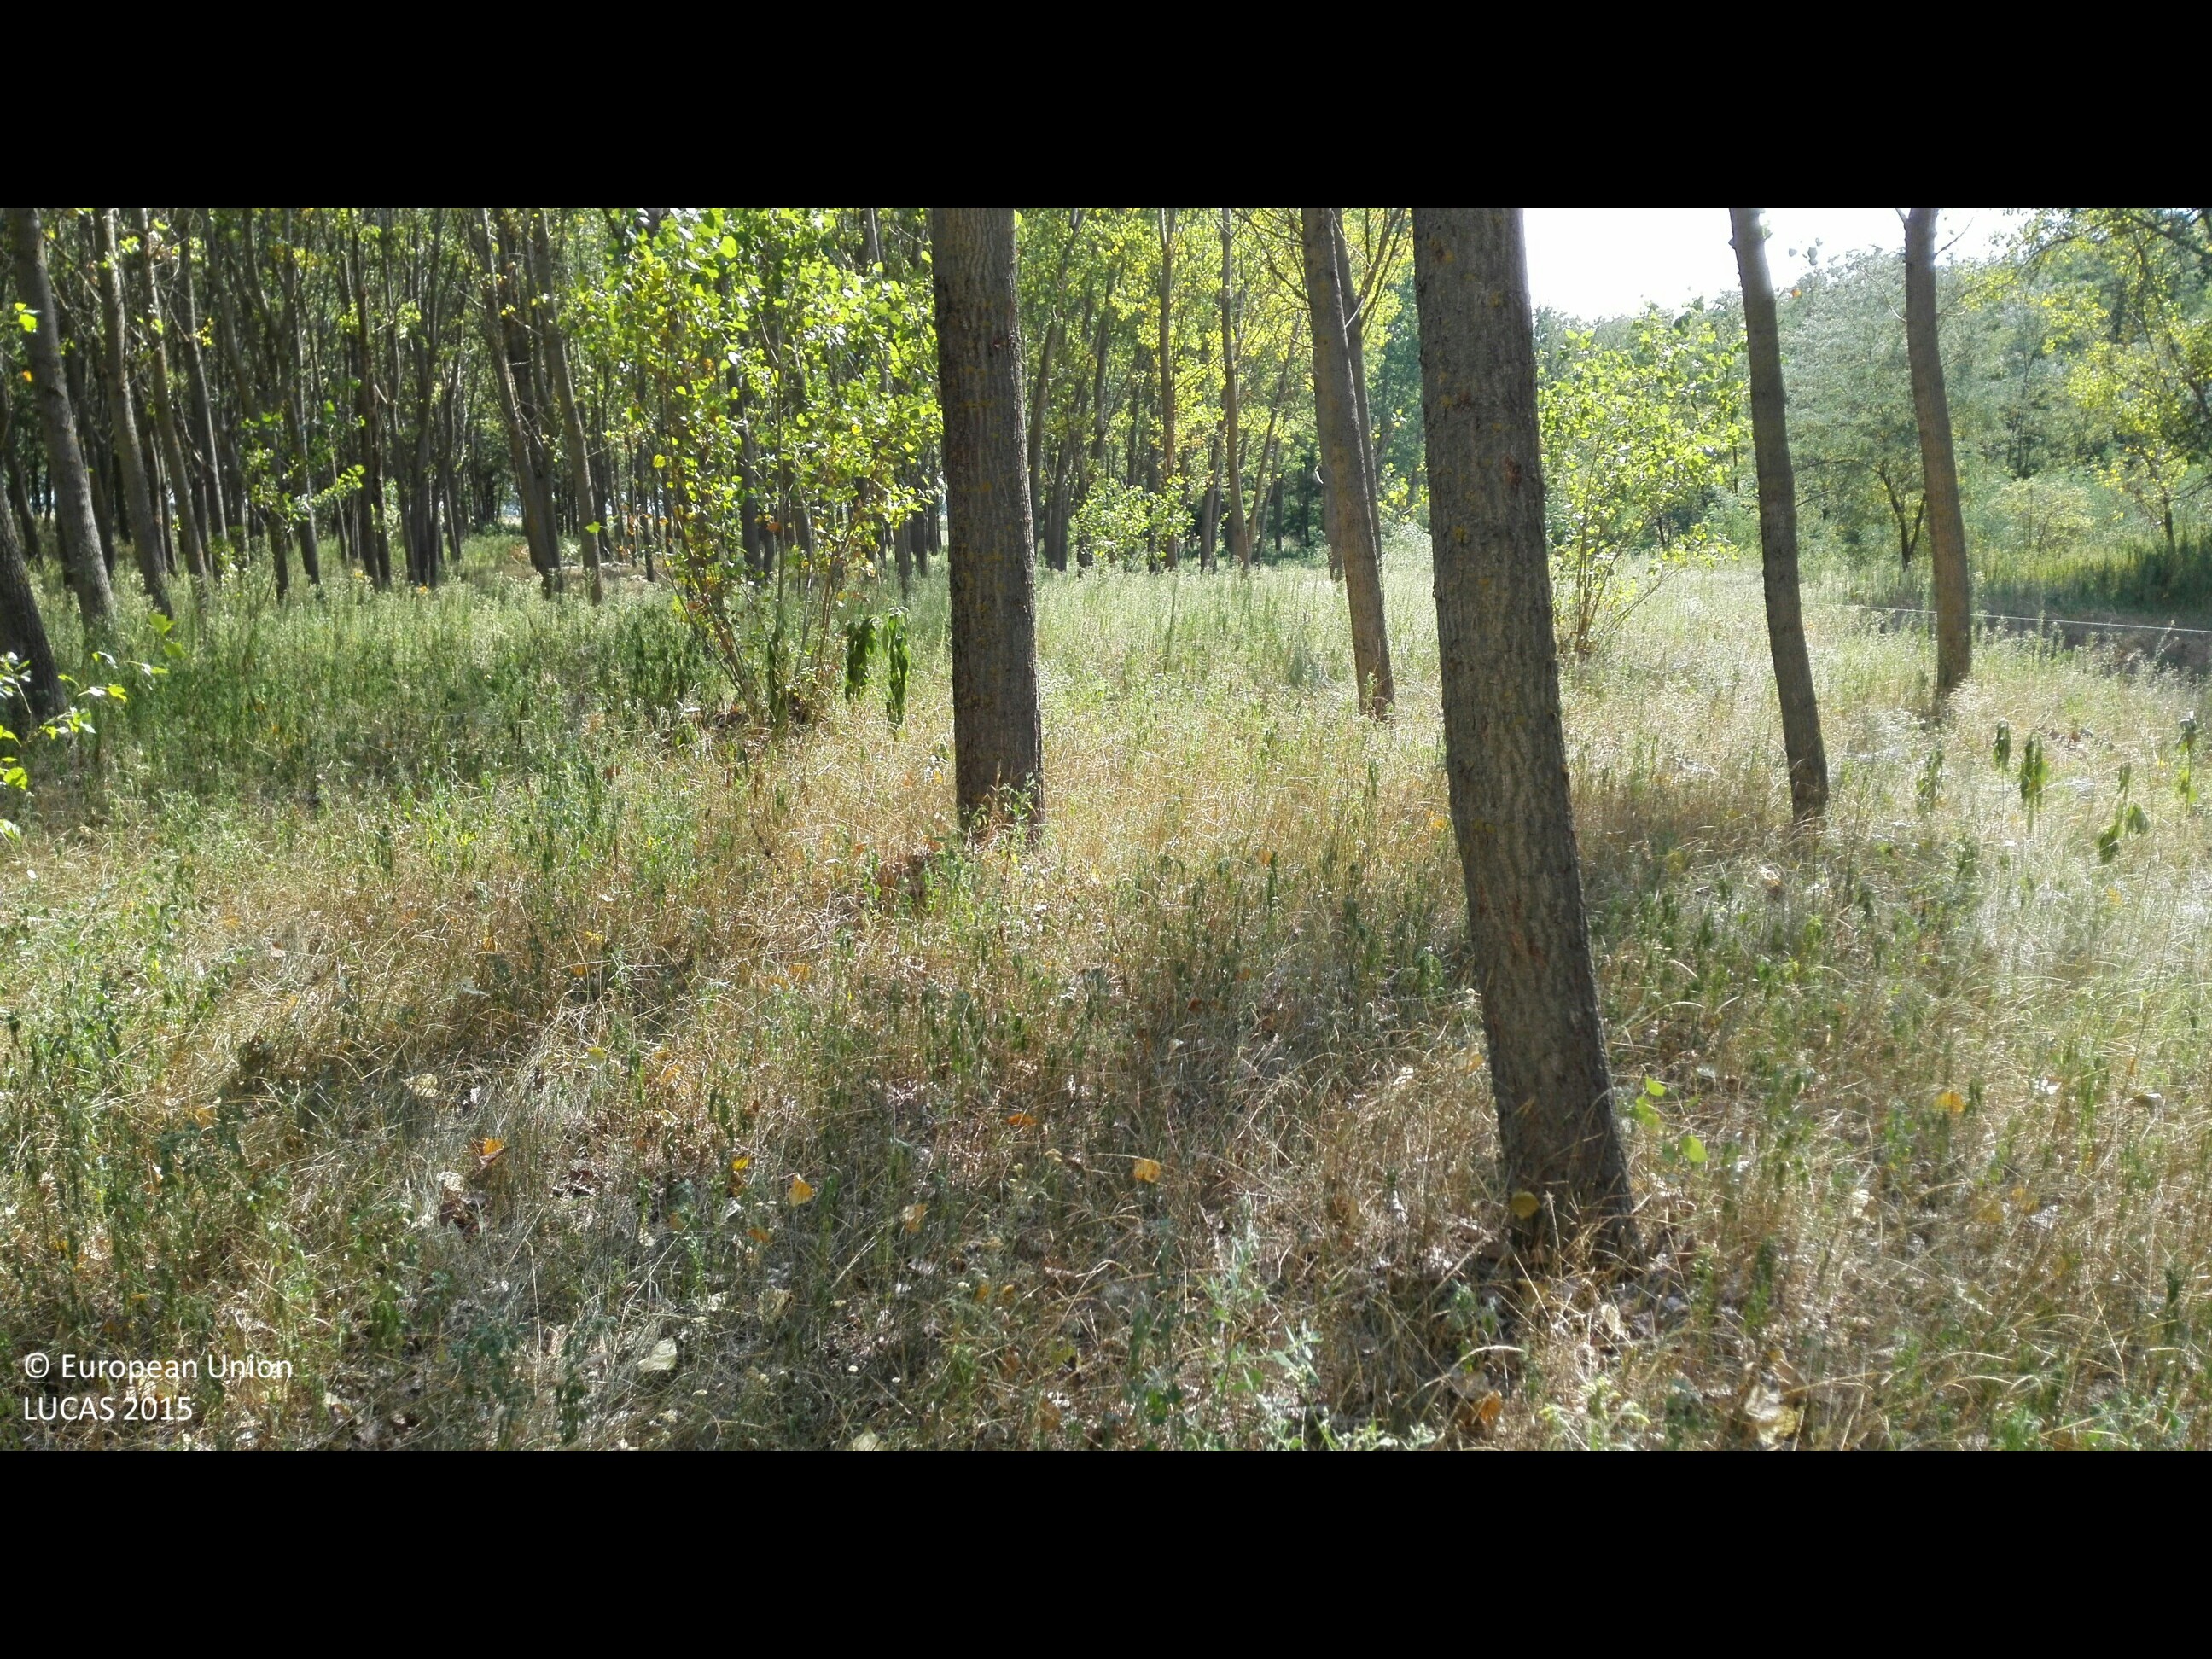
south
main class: Woodland
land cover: Broadleaved woodland
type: non-riverine alder, birch or aspen forest
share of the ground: > 75 %
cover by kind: broadleaved forest trees 90 %, herbaceous plants 10 %
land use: Forestry
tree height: > 5 m
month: August
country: HU
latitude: 47.3939
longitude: 21.9052
